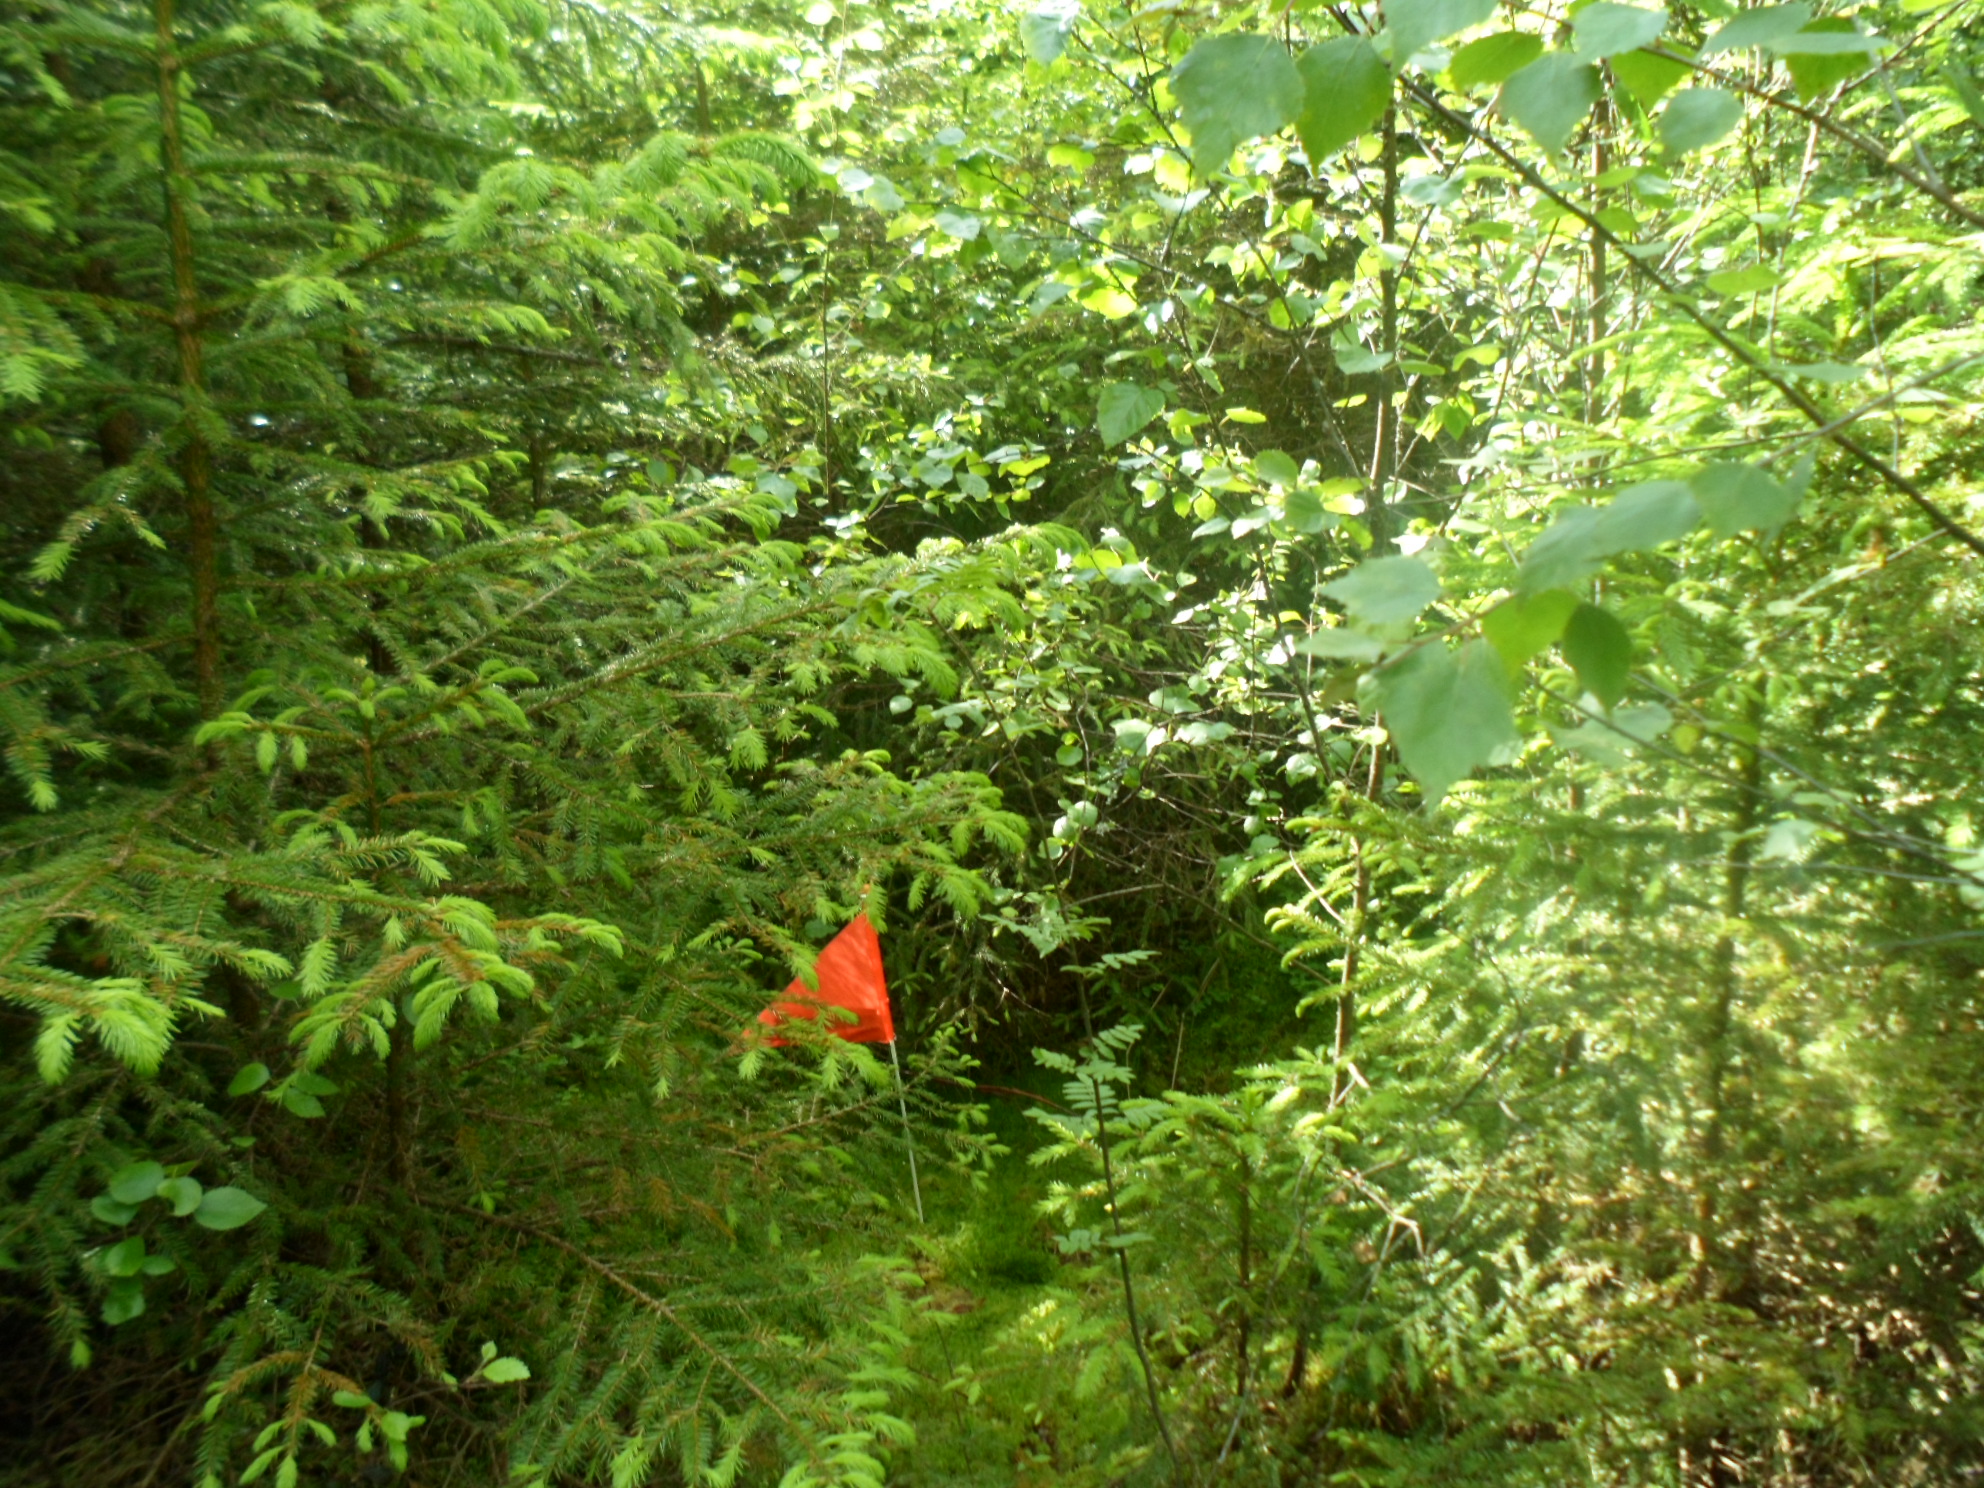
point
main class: Woodland
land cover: Spruce dominated mixed woodland
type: boreal forest
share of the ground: > 75 %
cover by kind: coniferous forest trees 40 %, broadleaved forest trees 40 %, lichens and mosses 10 %, shrubs 5 %, herbaceous plants 5 %
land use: Forestry
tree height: > 5 m
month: June
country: SE
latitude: 57.0194
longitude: 14.1966
